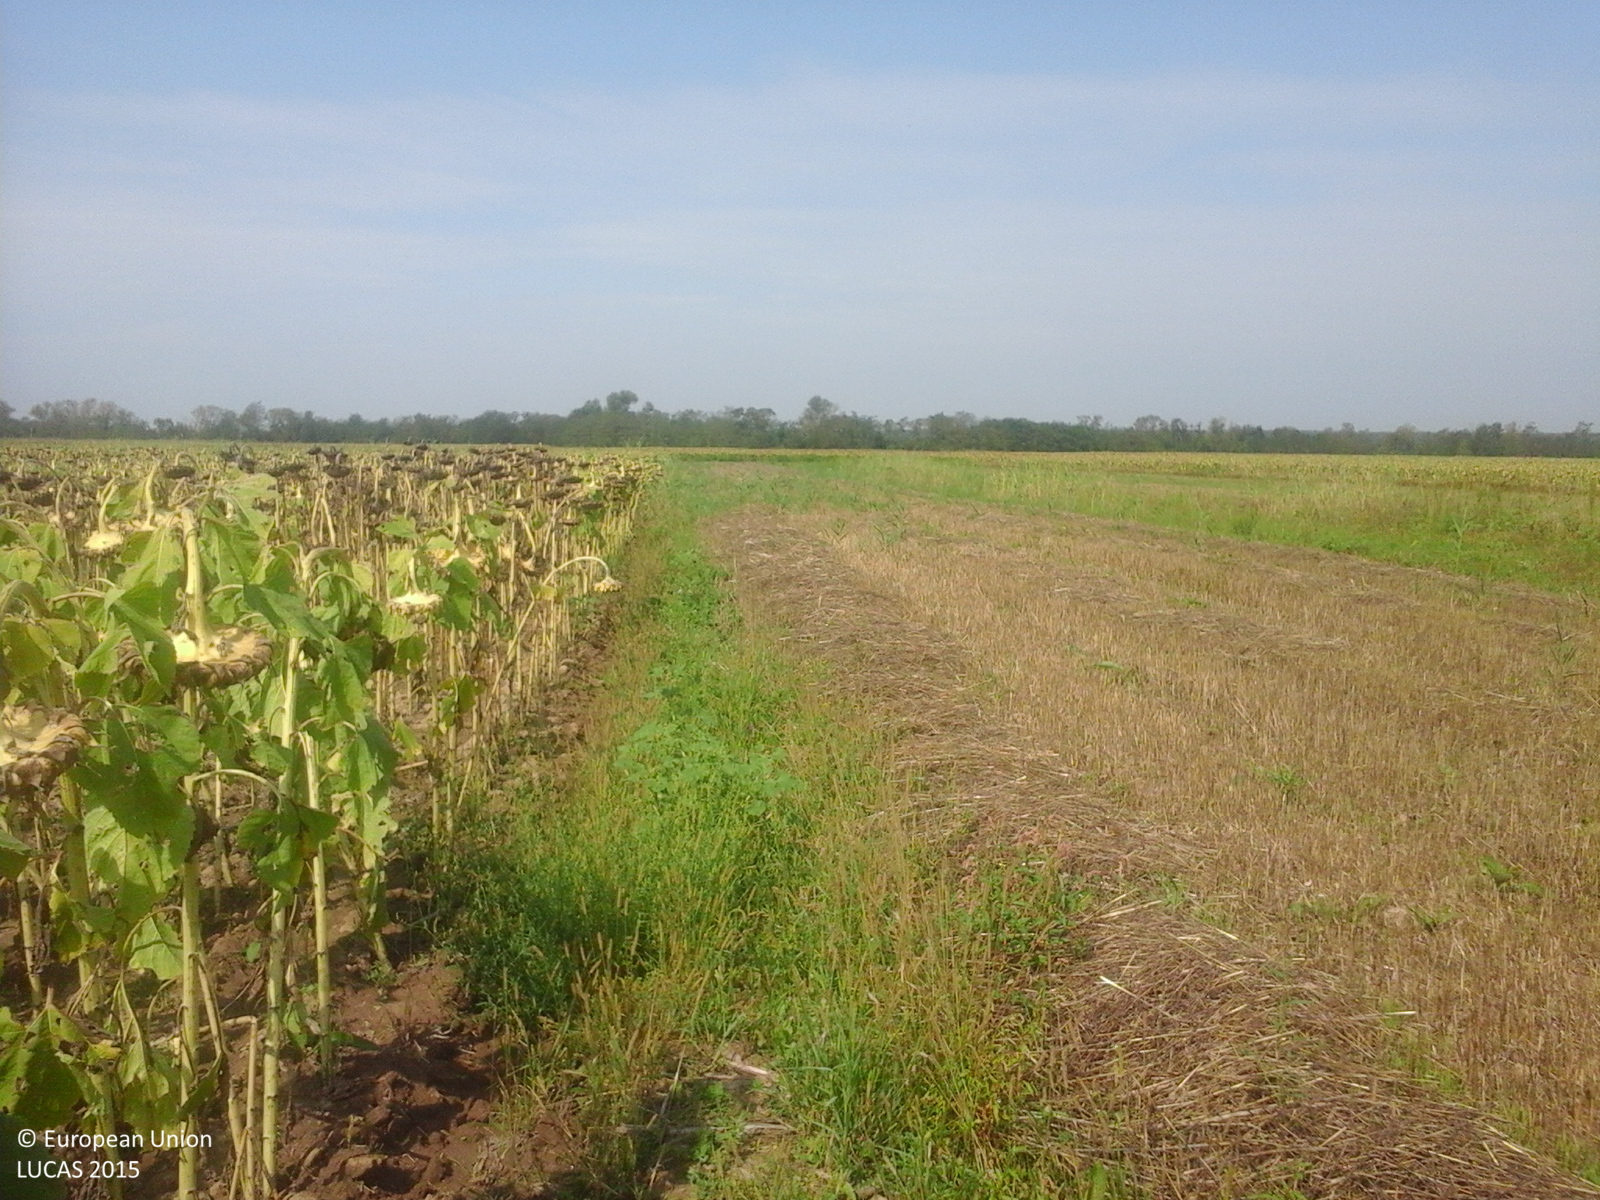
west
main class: Cropland
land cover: Sunflower
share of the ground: > 75 %
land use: Agriculture (excluding fallow land and kitchen gardens)
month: August
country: RO
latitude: 46.3063
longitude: 21.8702
